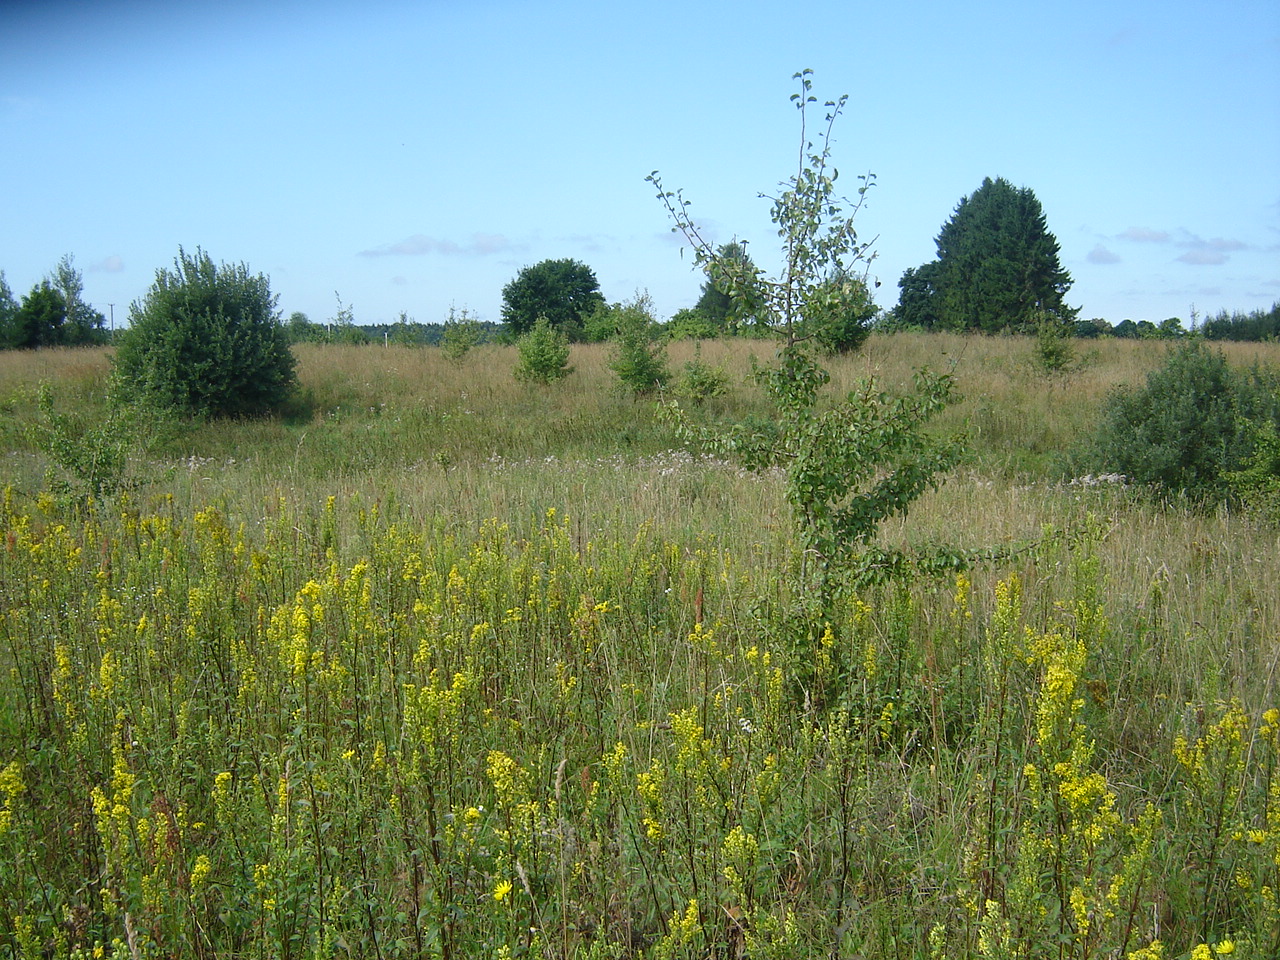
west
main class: Grassland
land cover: Grassland with sparse tree/shrub cover
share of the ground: > 75 %
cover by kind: herbaceous plants 90 %, broadleaved forest trees 5 %, shrubs 5 %
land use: Agriculture (excluding fallow land and kitchen gardens)
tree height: > 5 m
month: August
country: LT
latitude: 54.9274
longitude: 24.8887
